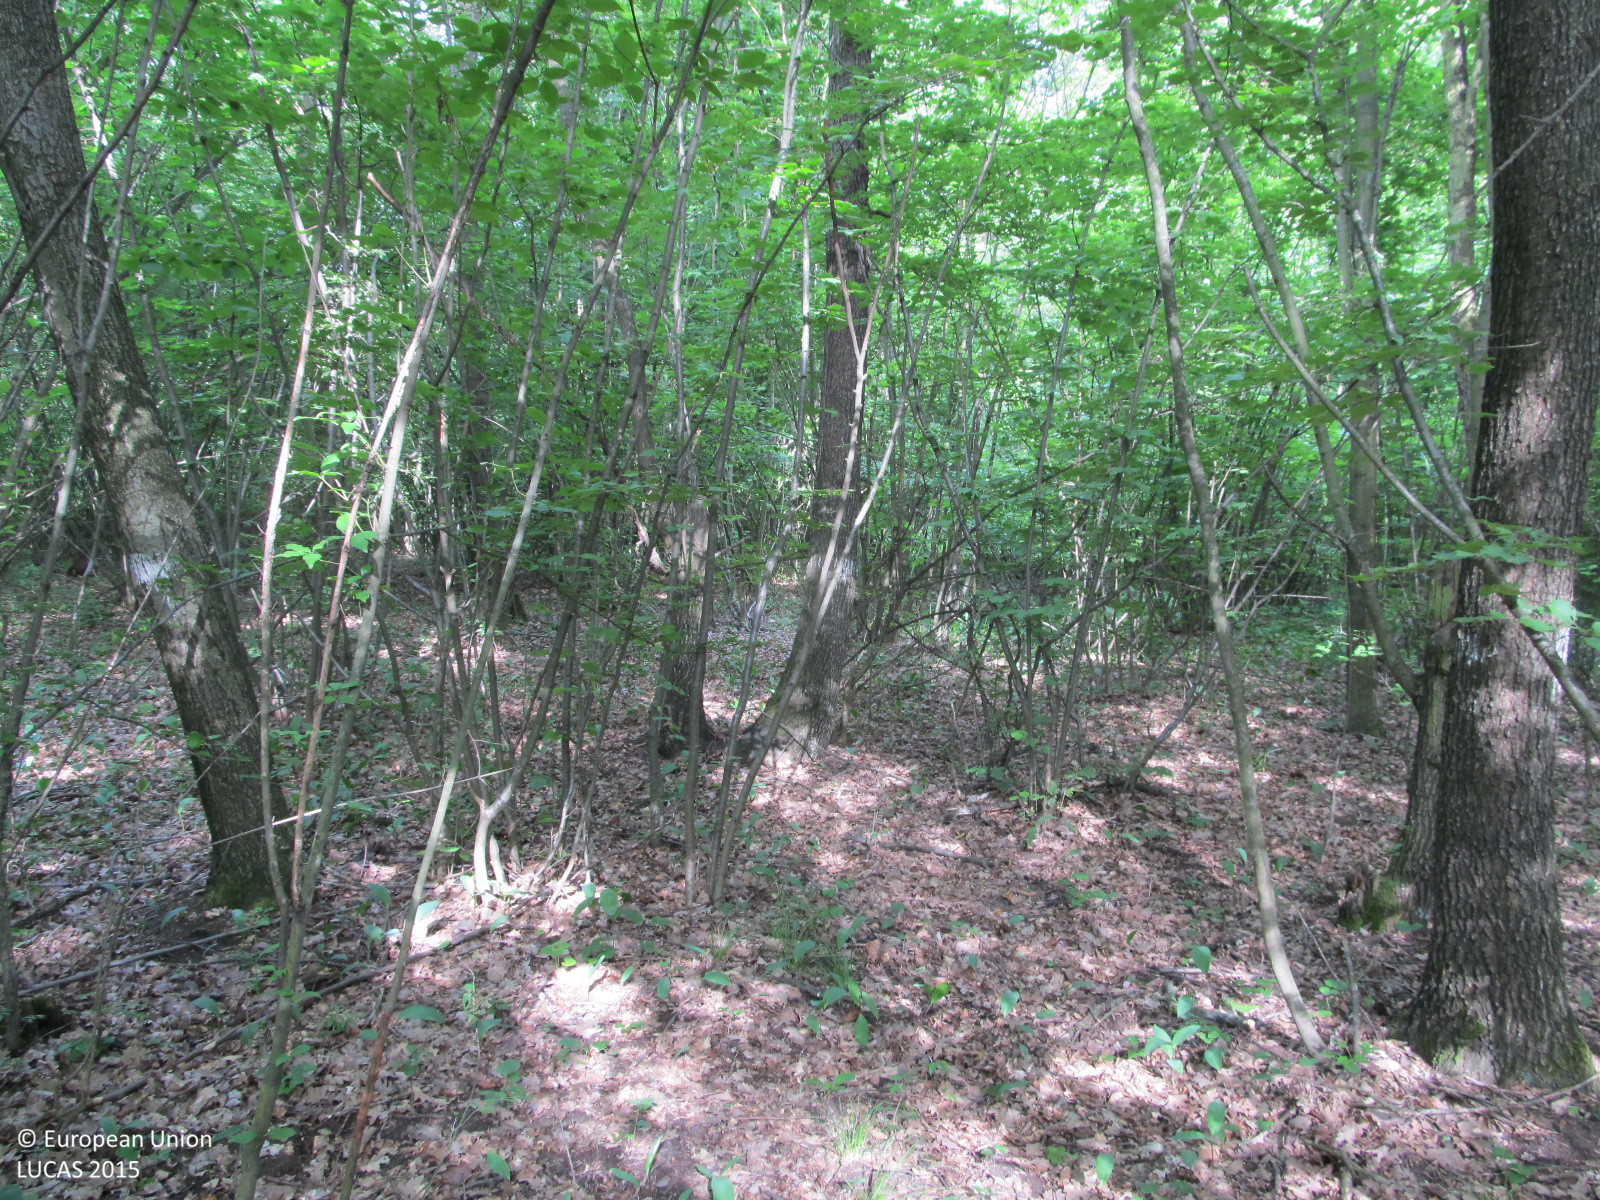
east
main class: Woodland
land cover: Broadleaved woodland
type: mesophytic deciduous forest
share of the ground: > 75 %
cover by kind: broadleaved forest trees 80 %, unconsolidated bare surface 10 %, shrubs 5 %, herbaceous plants 5 %
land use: Forestry
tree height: > 5 m
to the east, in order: Broadleaved woodland; Tracks; Broadleaved woodland
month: June
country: AT
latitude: 48.6650
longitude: 16.1558
